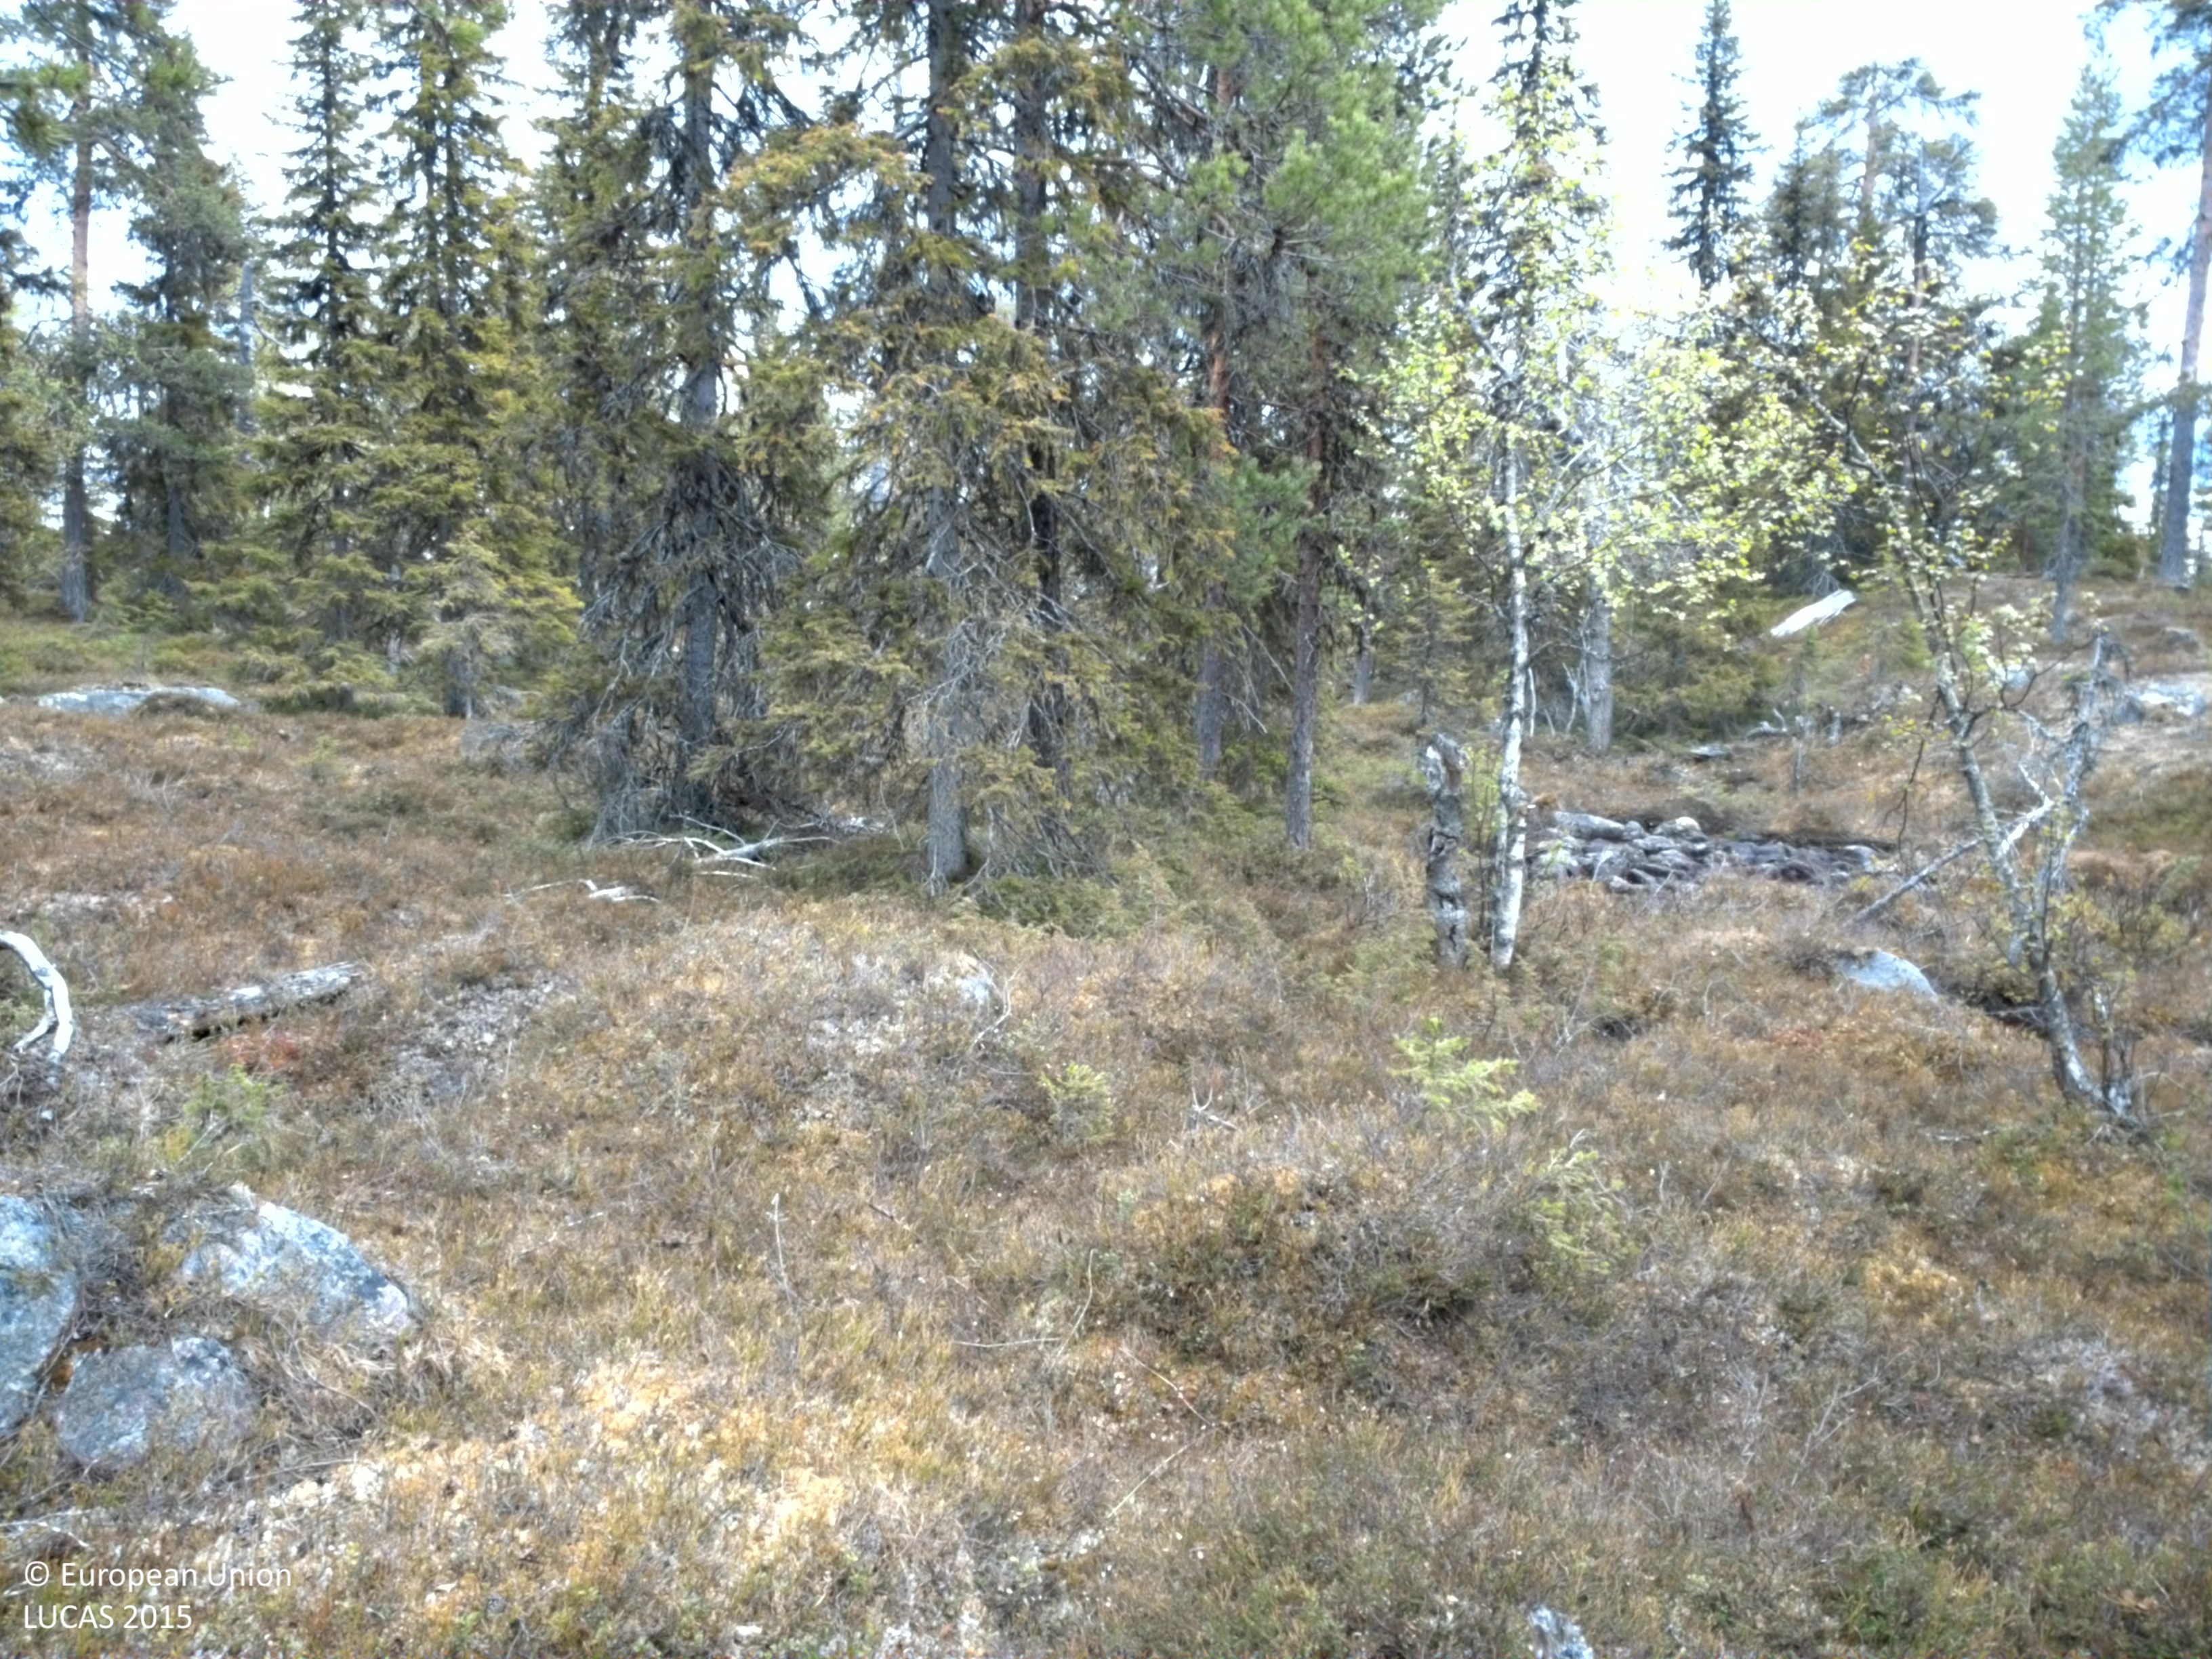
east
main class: Woodland
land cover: Spruce dominated coniferous woodland
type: boreal forest
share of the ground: 10 - 25 %
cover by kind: shrubs 70 %, coniferous forest trees 20 %, broadleaved forest trees 5 %, consolidated bare surface 5 %
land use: Forestry
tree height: > 5 m
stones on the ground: > 50 %
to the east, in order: Spruce dominated coniferous woodland; Pine dominated coniferous woodland; Other coniferous woodland; Pine dominated coniferous woodland
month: June
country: SE
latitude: 66.1025
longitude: 18.7817
